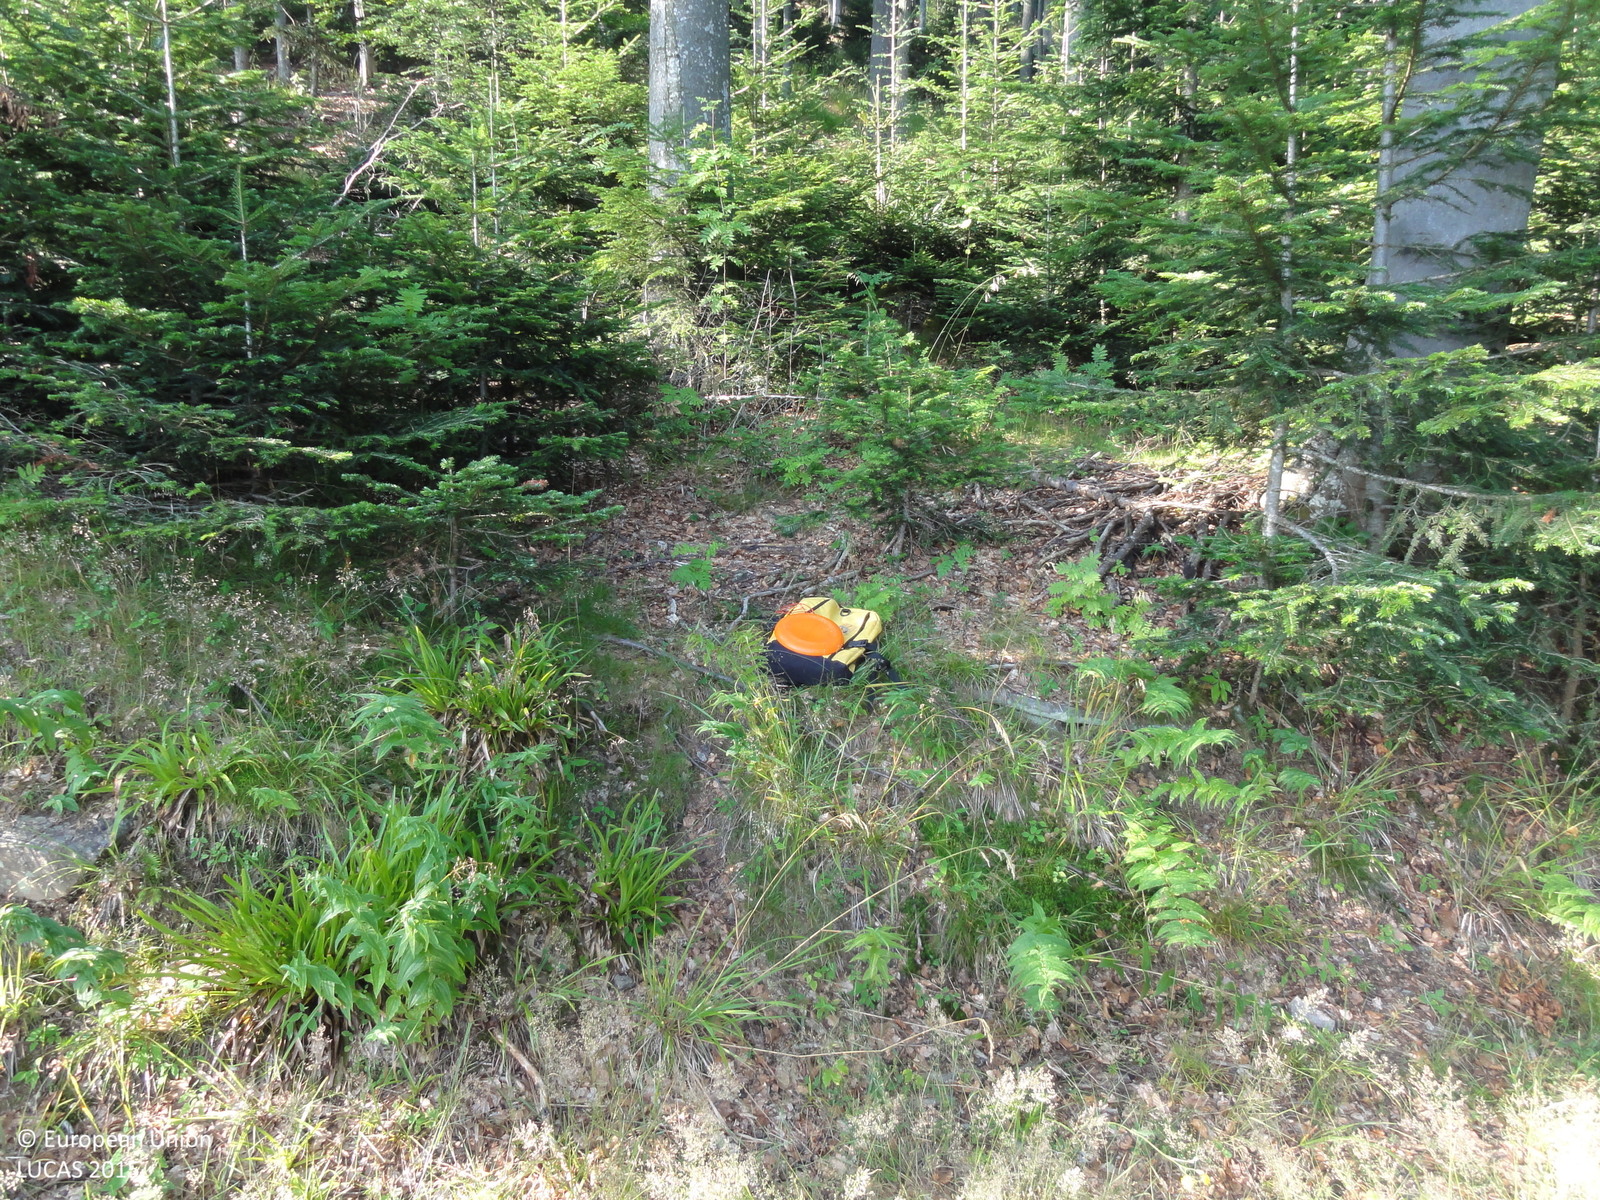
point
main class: Woodland
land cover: Spruce dominated mixed woodland
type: mountainous beech forest
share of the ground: > 75 %
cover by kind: coniferous forest trees 50 %, broadleaved forest trees 30 %, herbaceous plants 20 %
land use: Forestry
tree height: > 5 m
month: July
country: SI
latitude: 46.5133
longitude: 15.5641
